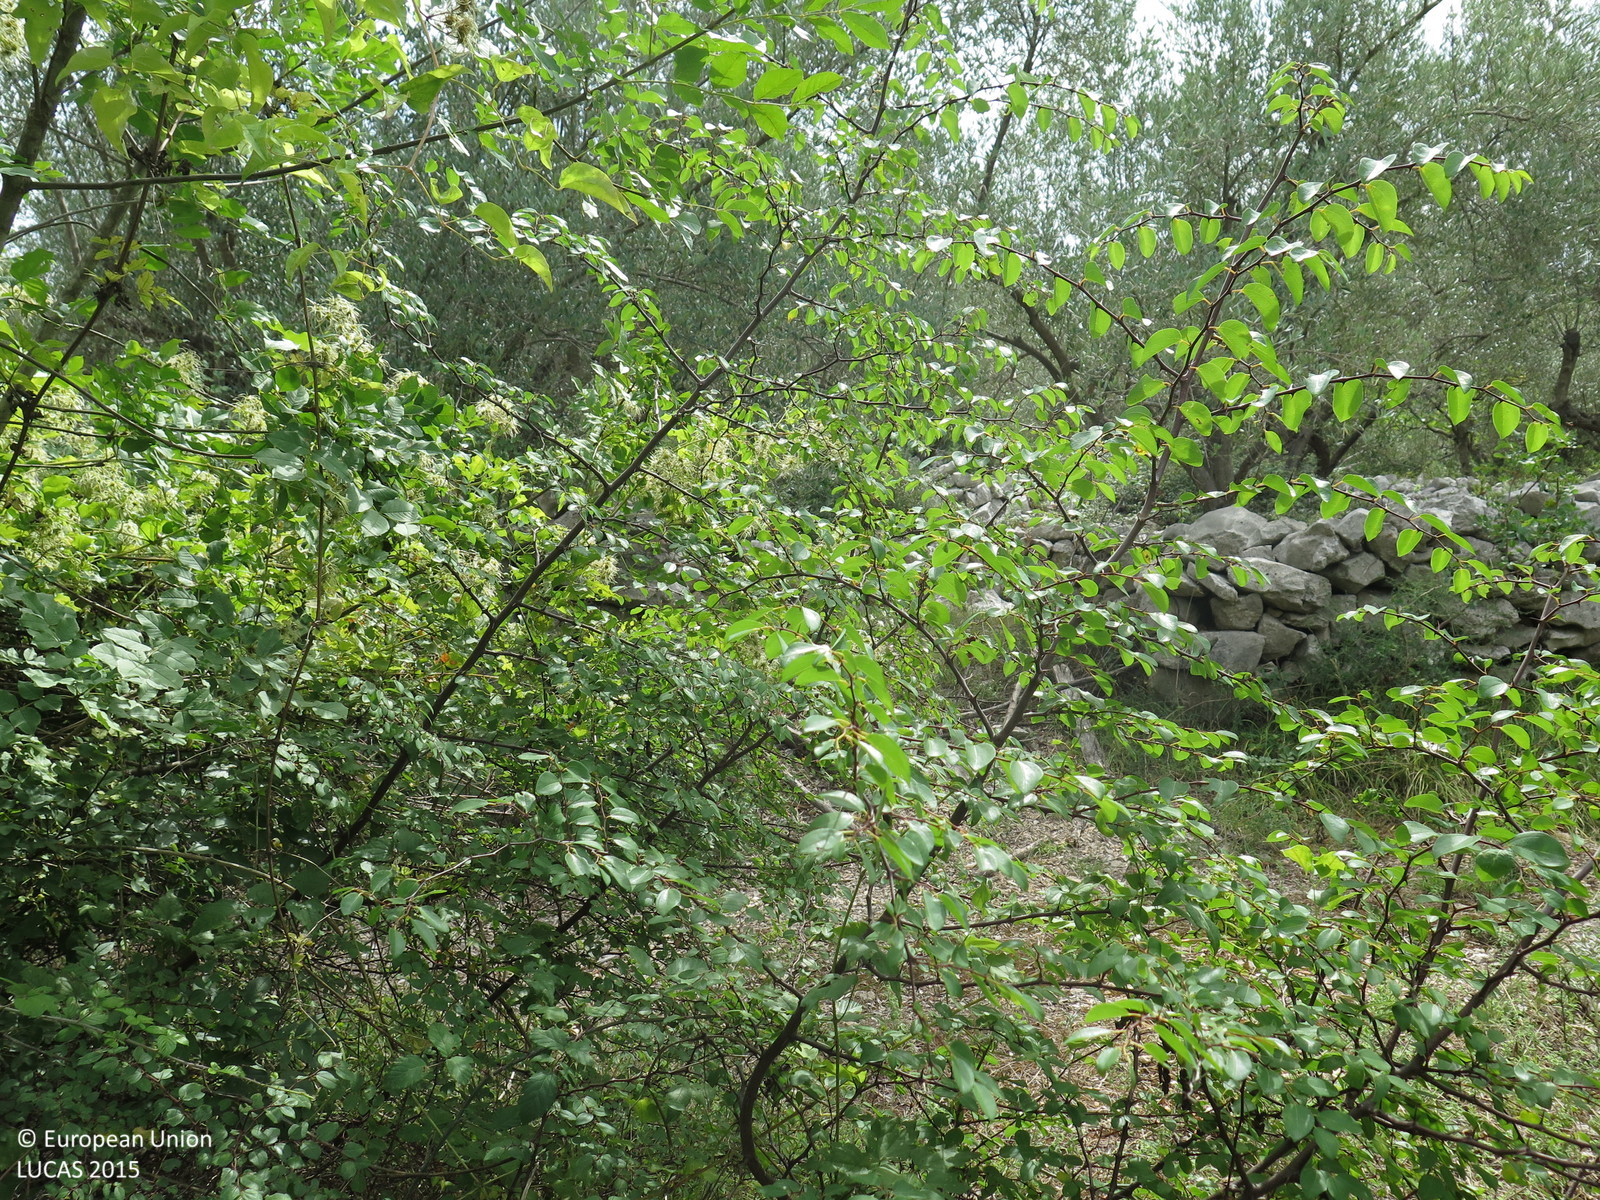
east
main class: Woodland
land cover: Broadleaved woodland
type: thermophilous deciduous forest
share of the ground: > 75 %
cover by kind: broadleaved forest trees 90 %, shrubs 5 %, herbaceous plants 5 %
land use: Semi-natural and natural areas not in use
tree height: > 5 m
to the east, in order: Broadleaved woodland; Dry stone walls; Broadleaved woodland; Dry stone walls; Broadleaved woodland; Dry stone walls; Grassland with sparse tree/shrub cover; Dry stone walls; Broadleaved woodland
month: August
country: HR
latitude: 45.1498
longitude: 14.6371
